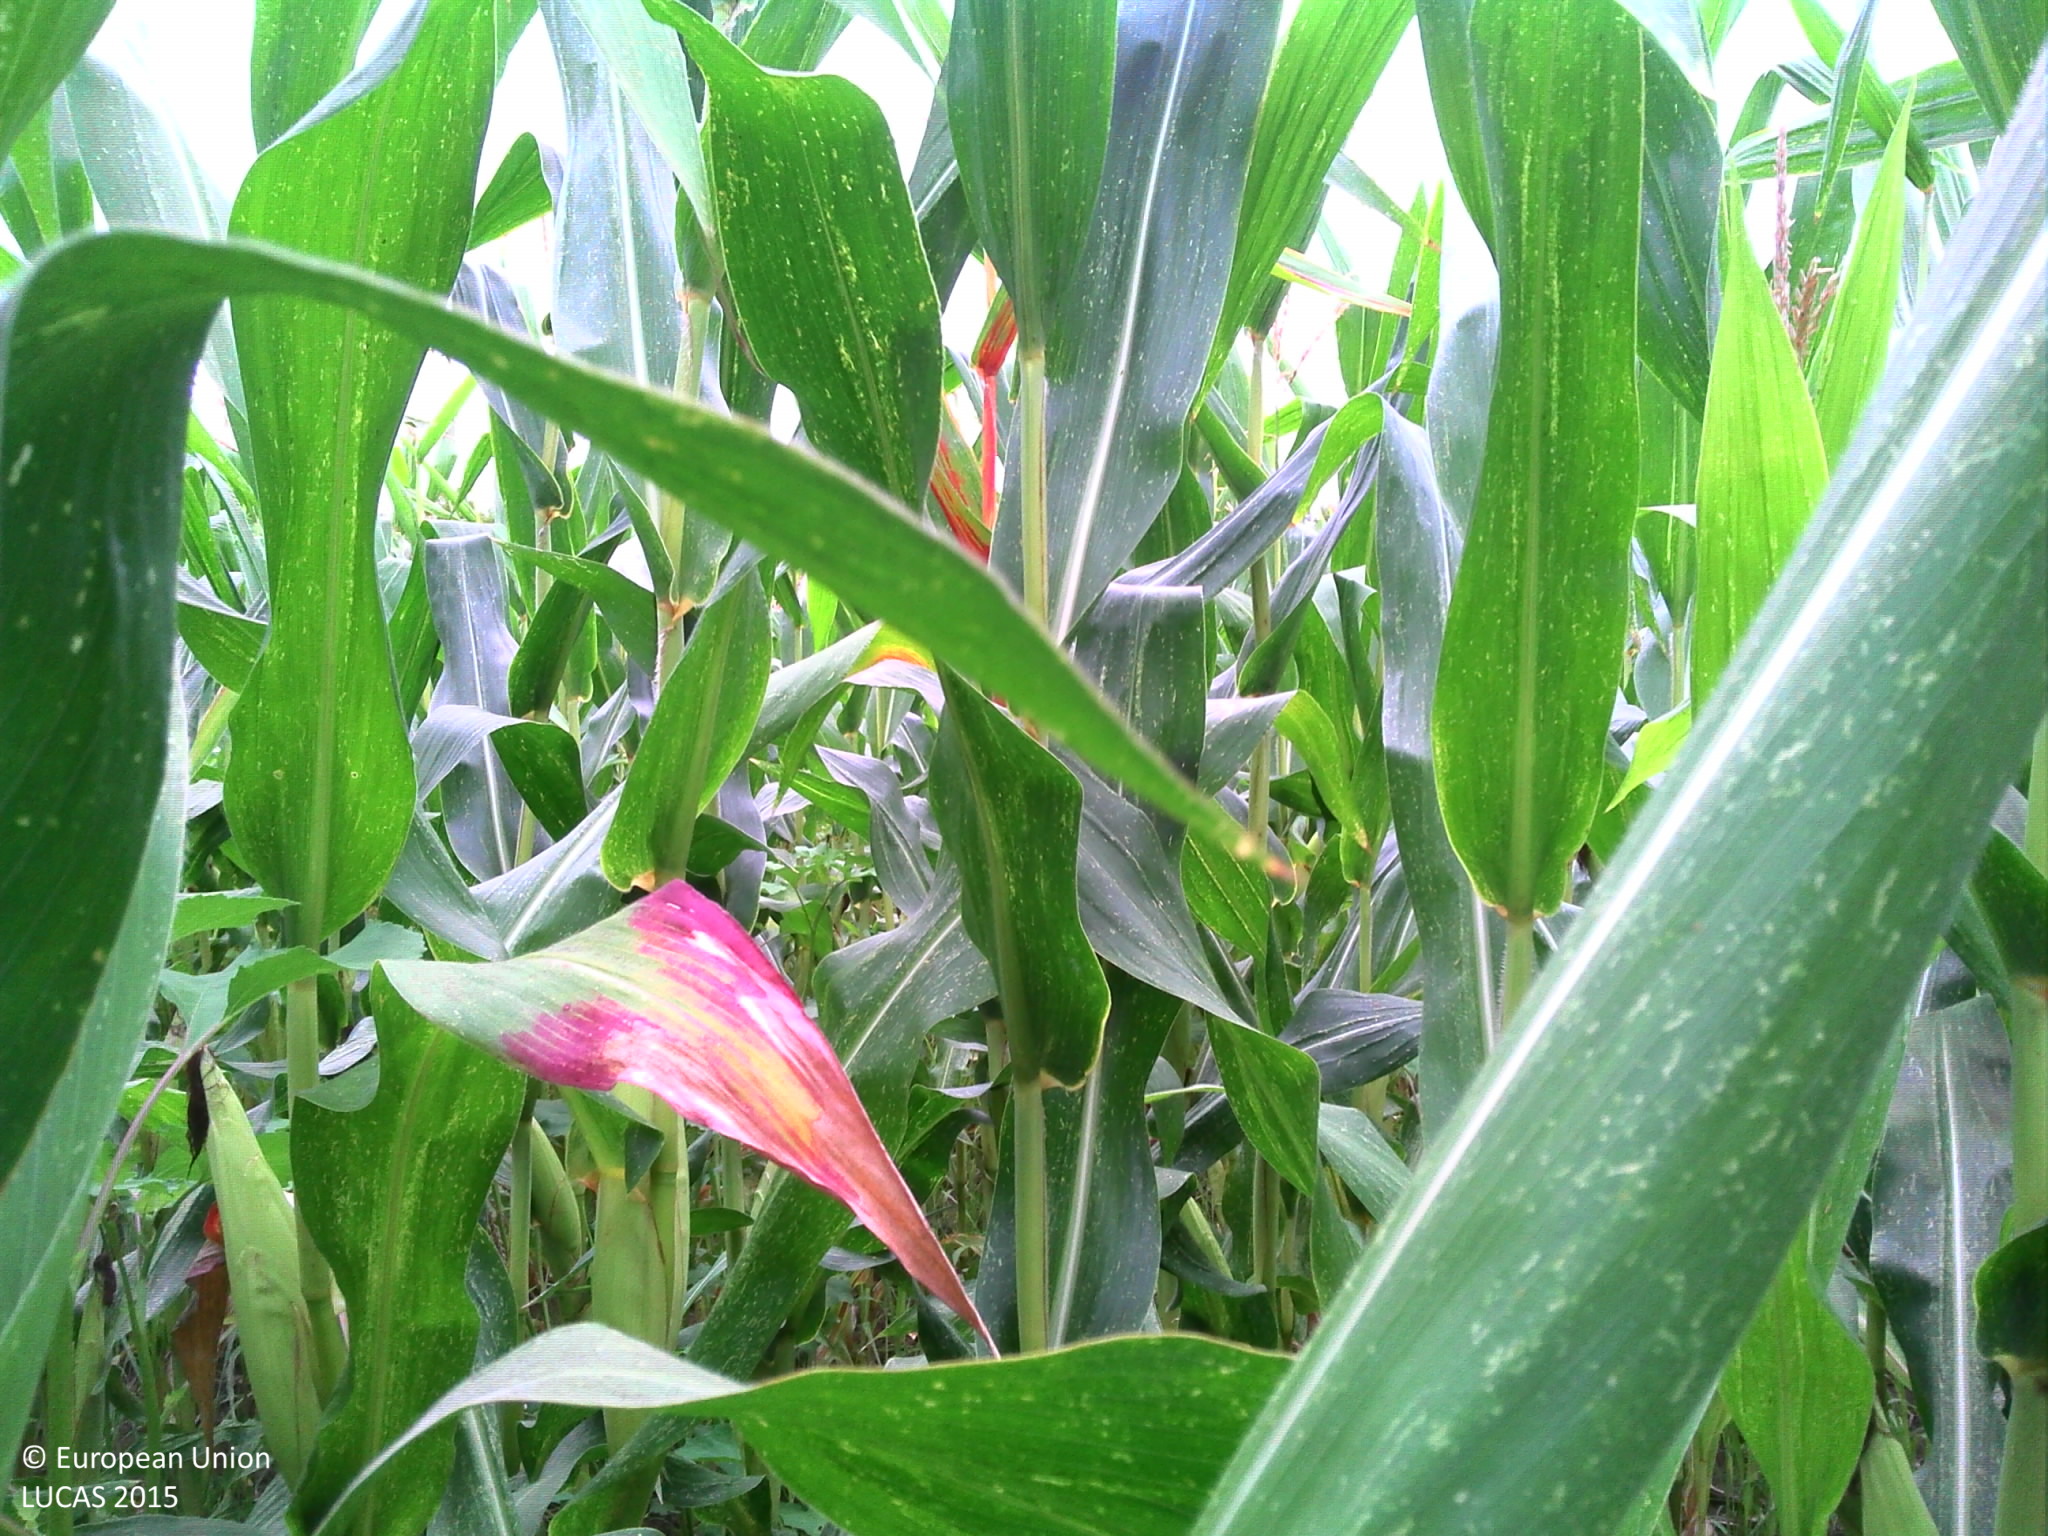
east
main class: Cropland
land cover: Maize
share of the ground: > 75 %
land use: Agriculture (excluding fallow land and kitchen gardens)
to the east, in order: Maize; Grass margins; Tracks; Ditches and canals; Spontaneously vegetated surfaces; Other fruit trees and berries; Grassland without tree/shrub cover; Other fruit trees and berries; Grassland without tree/shrub cover; Tracks; Grassland without tree/shrub cover; Other fruit trees and berries; Spontaneously vegetated surfaces
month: July
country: FR
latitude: 44.3985
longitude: 0.6401
